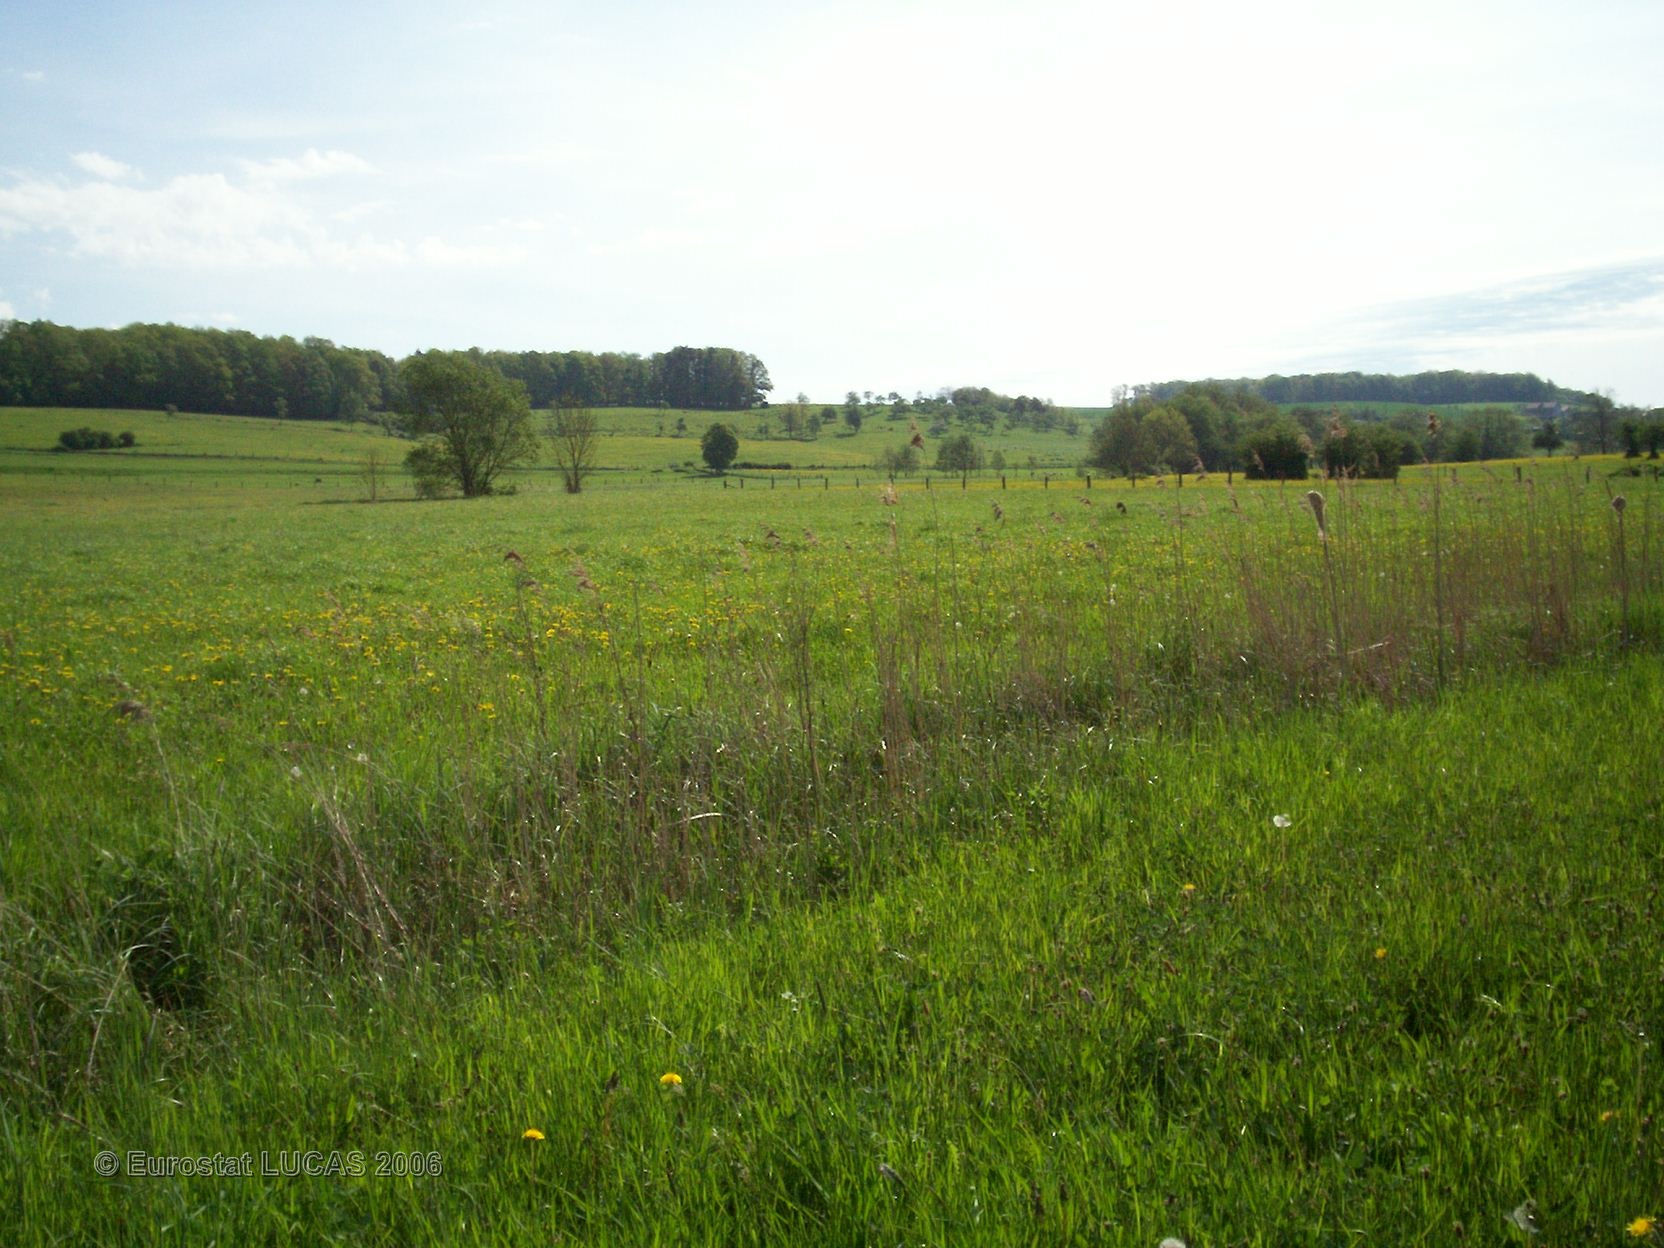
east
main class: Grassland
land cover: Grassland without tree/shrub cover
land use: Agriculture (excluding fallow land and kitchen gardens)
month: May
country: FR
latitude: 48.2931
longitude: 5.9430
